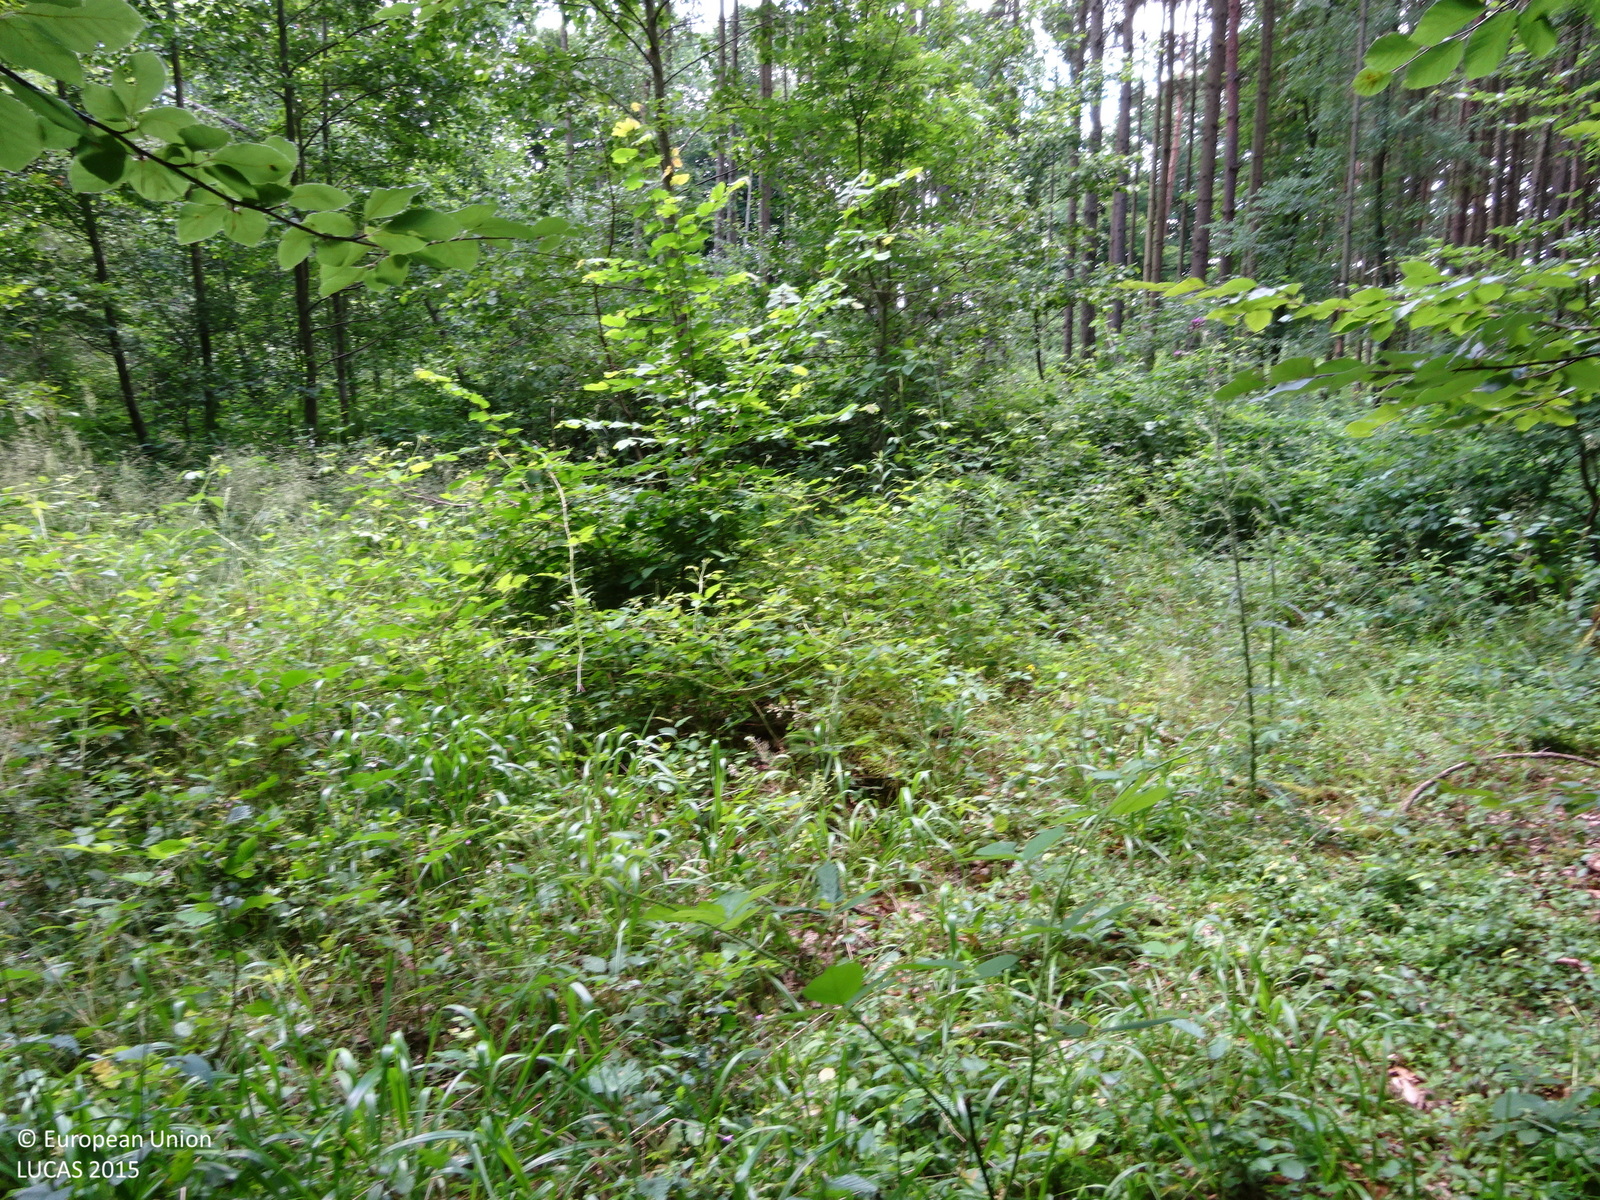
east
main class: Woodland
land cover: Broadleaved woodland
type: mountainous beech forest
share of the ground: > 75 %
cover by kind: broadleaved forest trees 80 %, coniferous forest trees 20 %
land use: Forestry
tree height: > 5 m
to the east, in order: Broadleaved woodland; Other coniferous woodland; Broadleaved woodland; Spruce dominated mixed woodland; Tracks; Maize; Tracks; Maize; Tracks; Ditches and canals; Spruce dominated mixed woodland; Tracks; Spruce dominated coniferous woodland
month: June
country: AT
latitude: 46.7450
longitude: 15.9558
